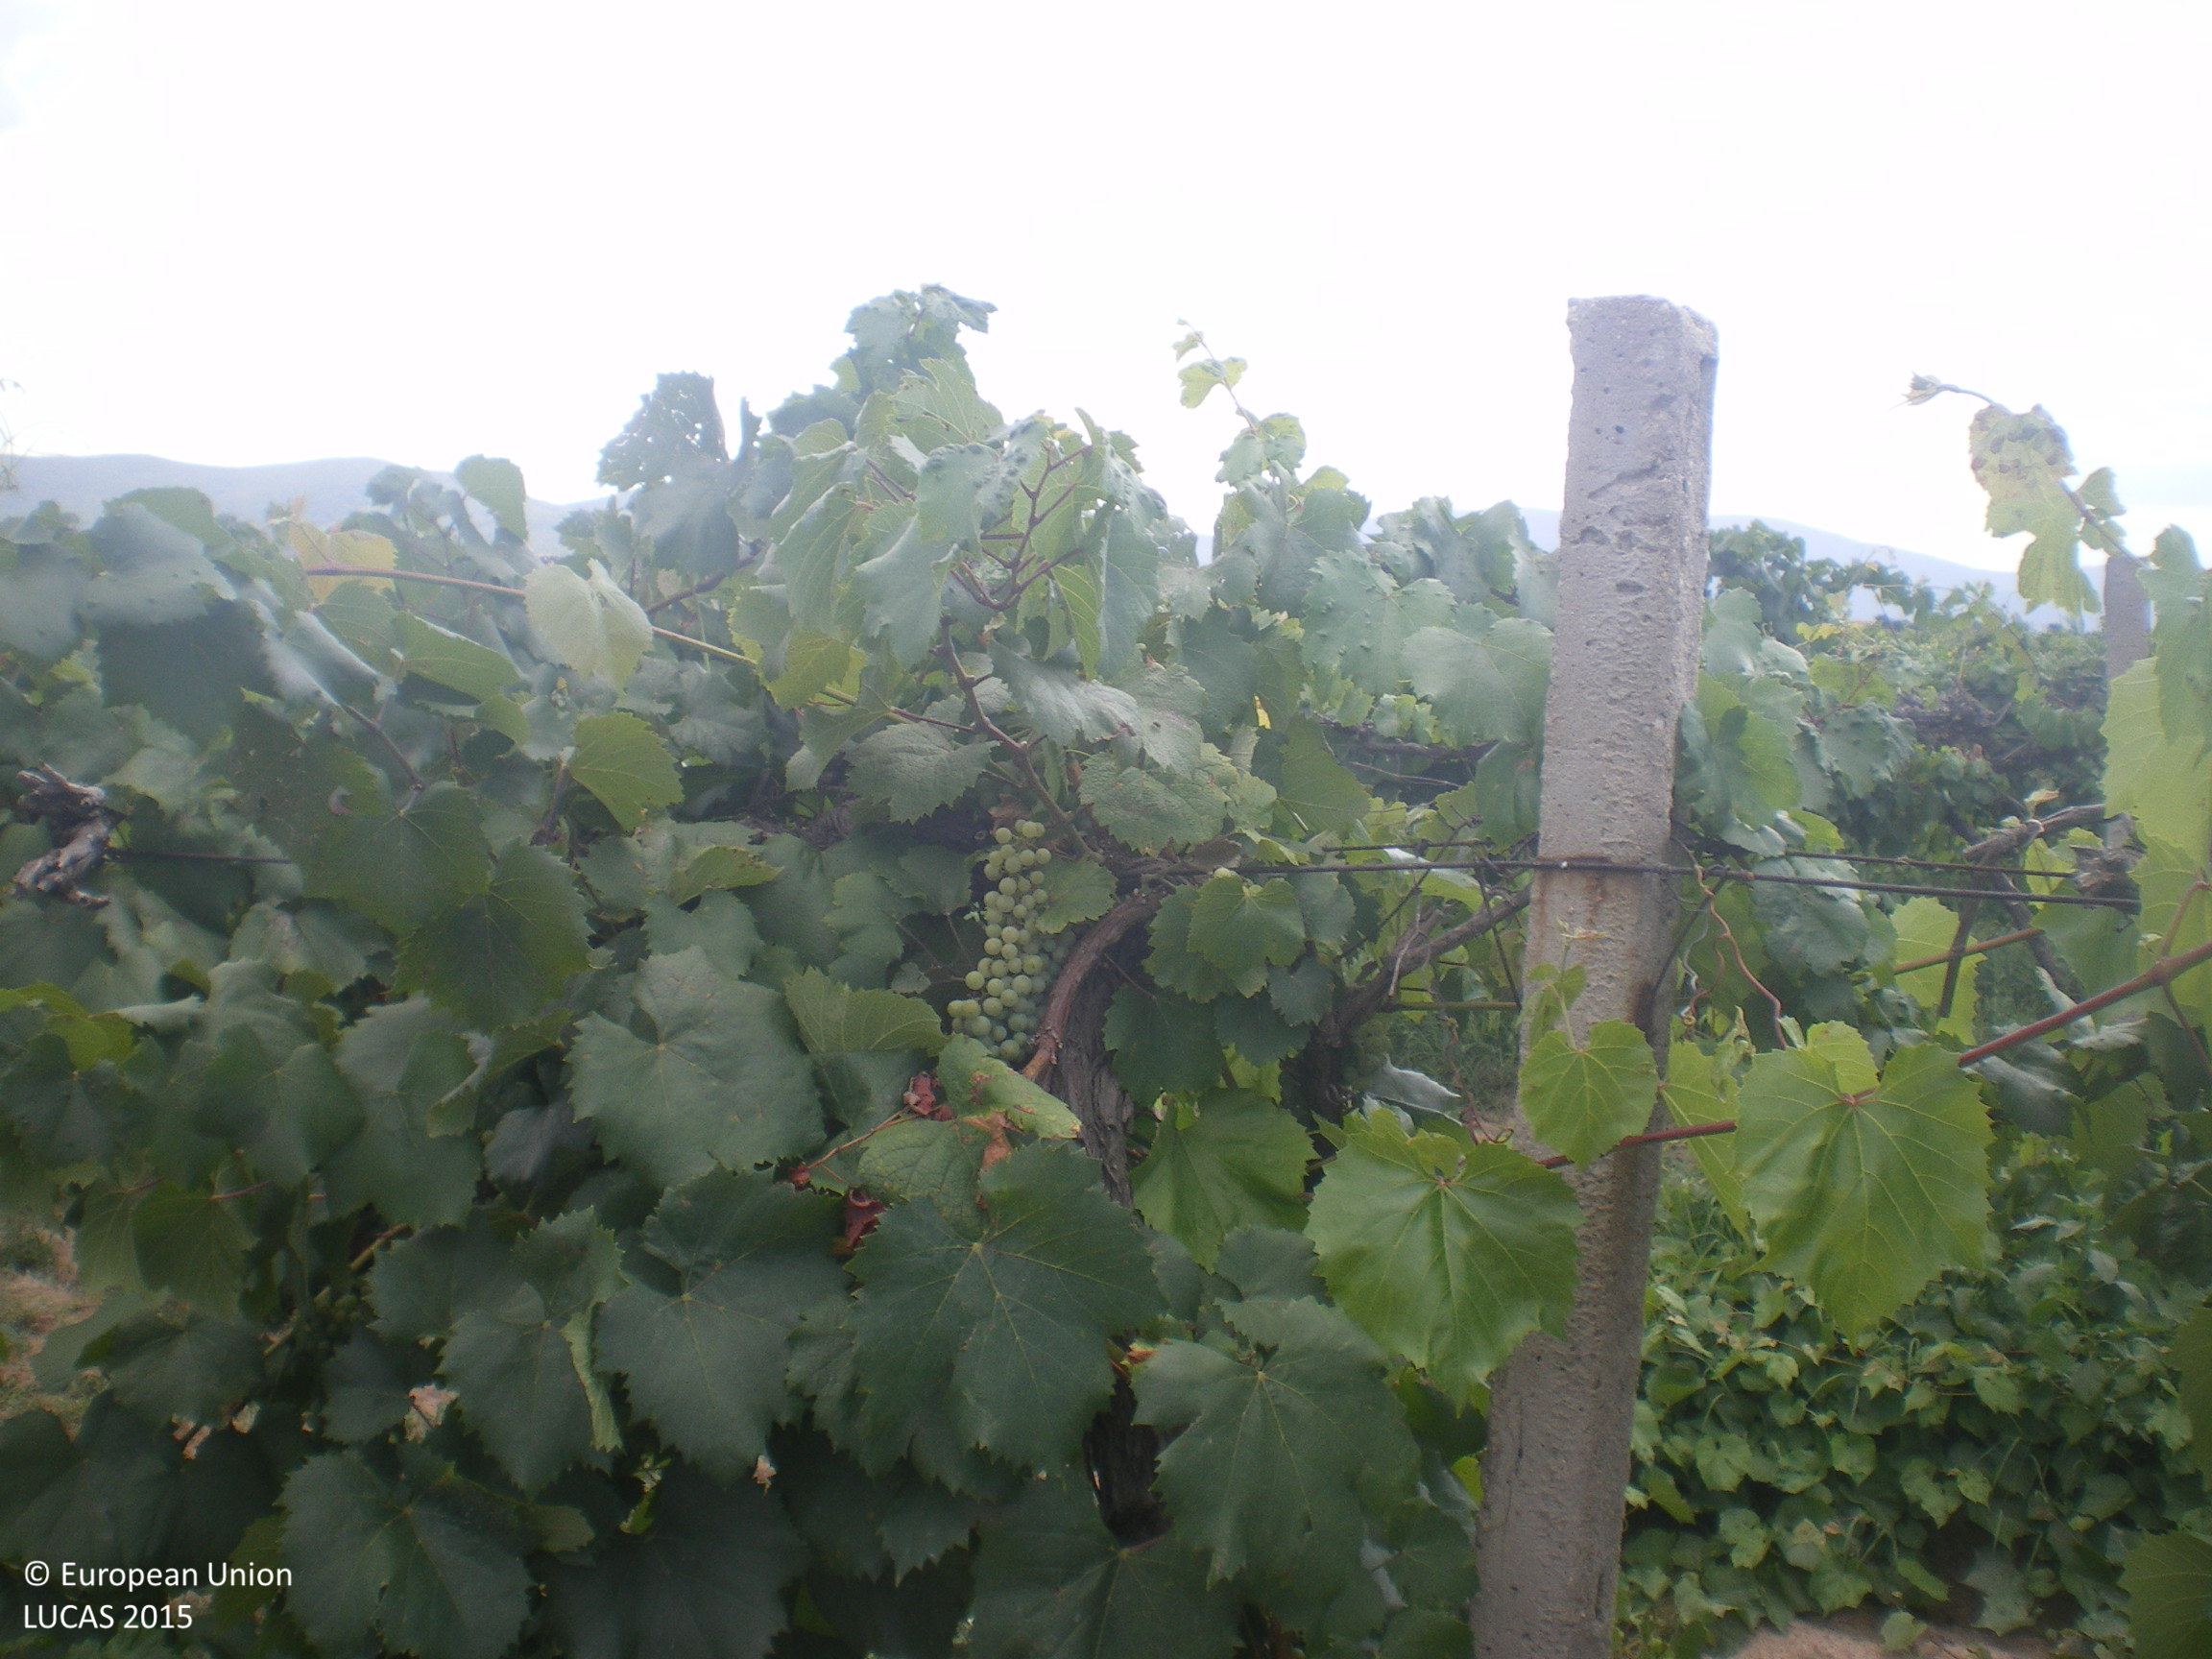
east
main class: Cropland
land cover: Vineyards
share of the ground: 50 - 75 %
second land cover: Other bare soil
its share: > 75 %
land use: Agriculture (excluding fallow land and kitchen gardens)
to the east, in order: Vineyards; Other bare soil; Tracks; Vineyards
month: August
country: BG
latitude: 42.6105
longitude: 25.8404
